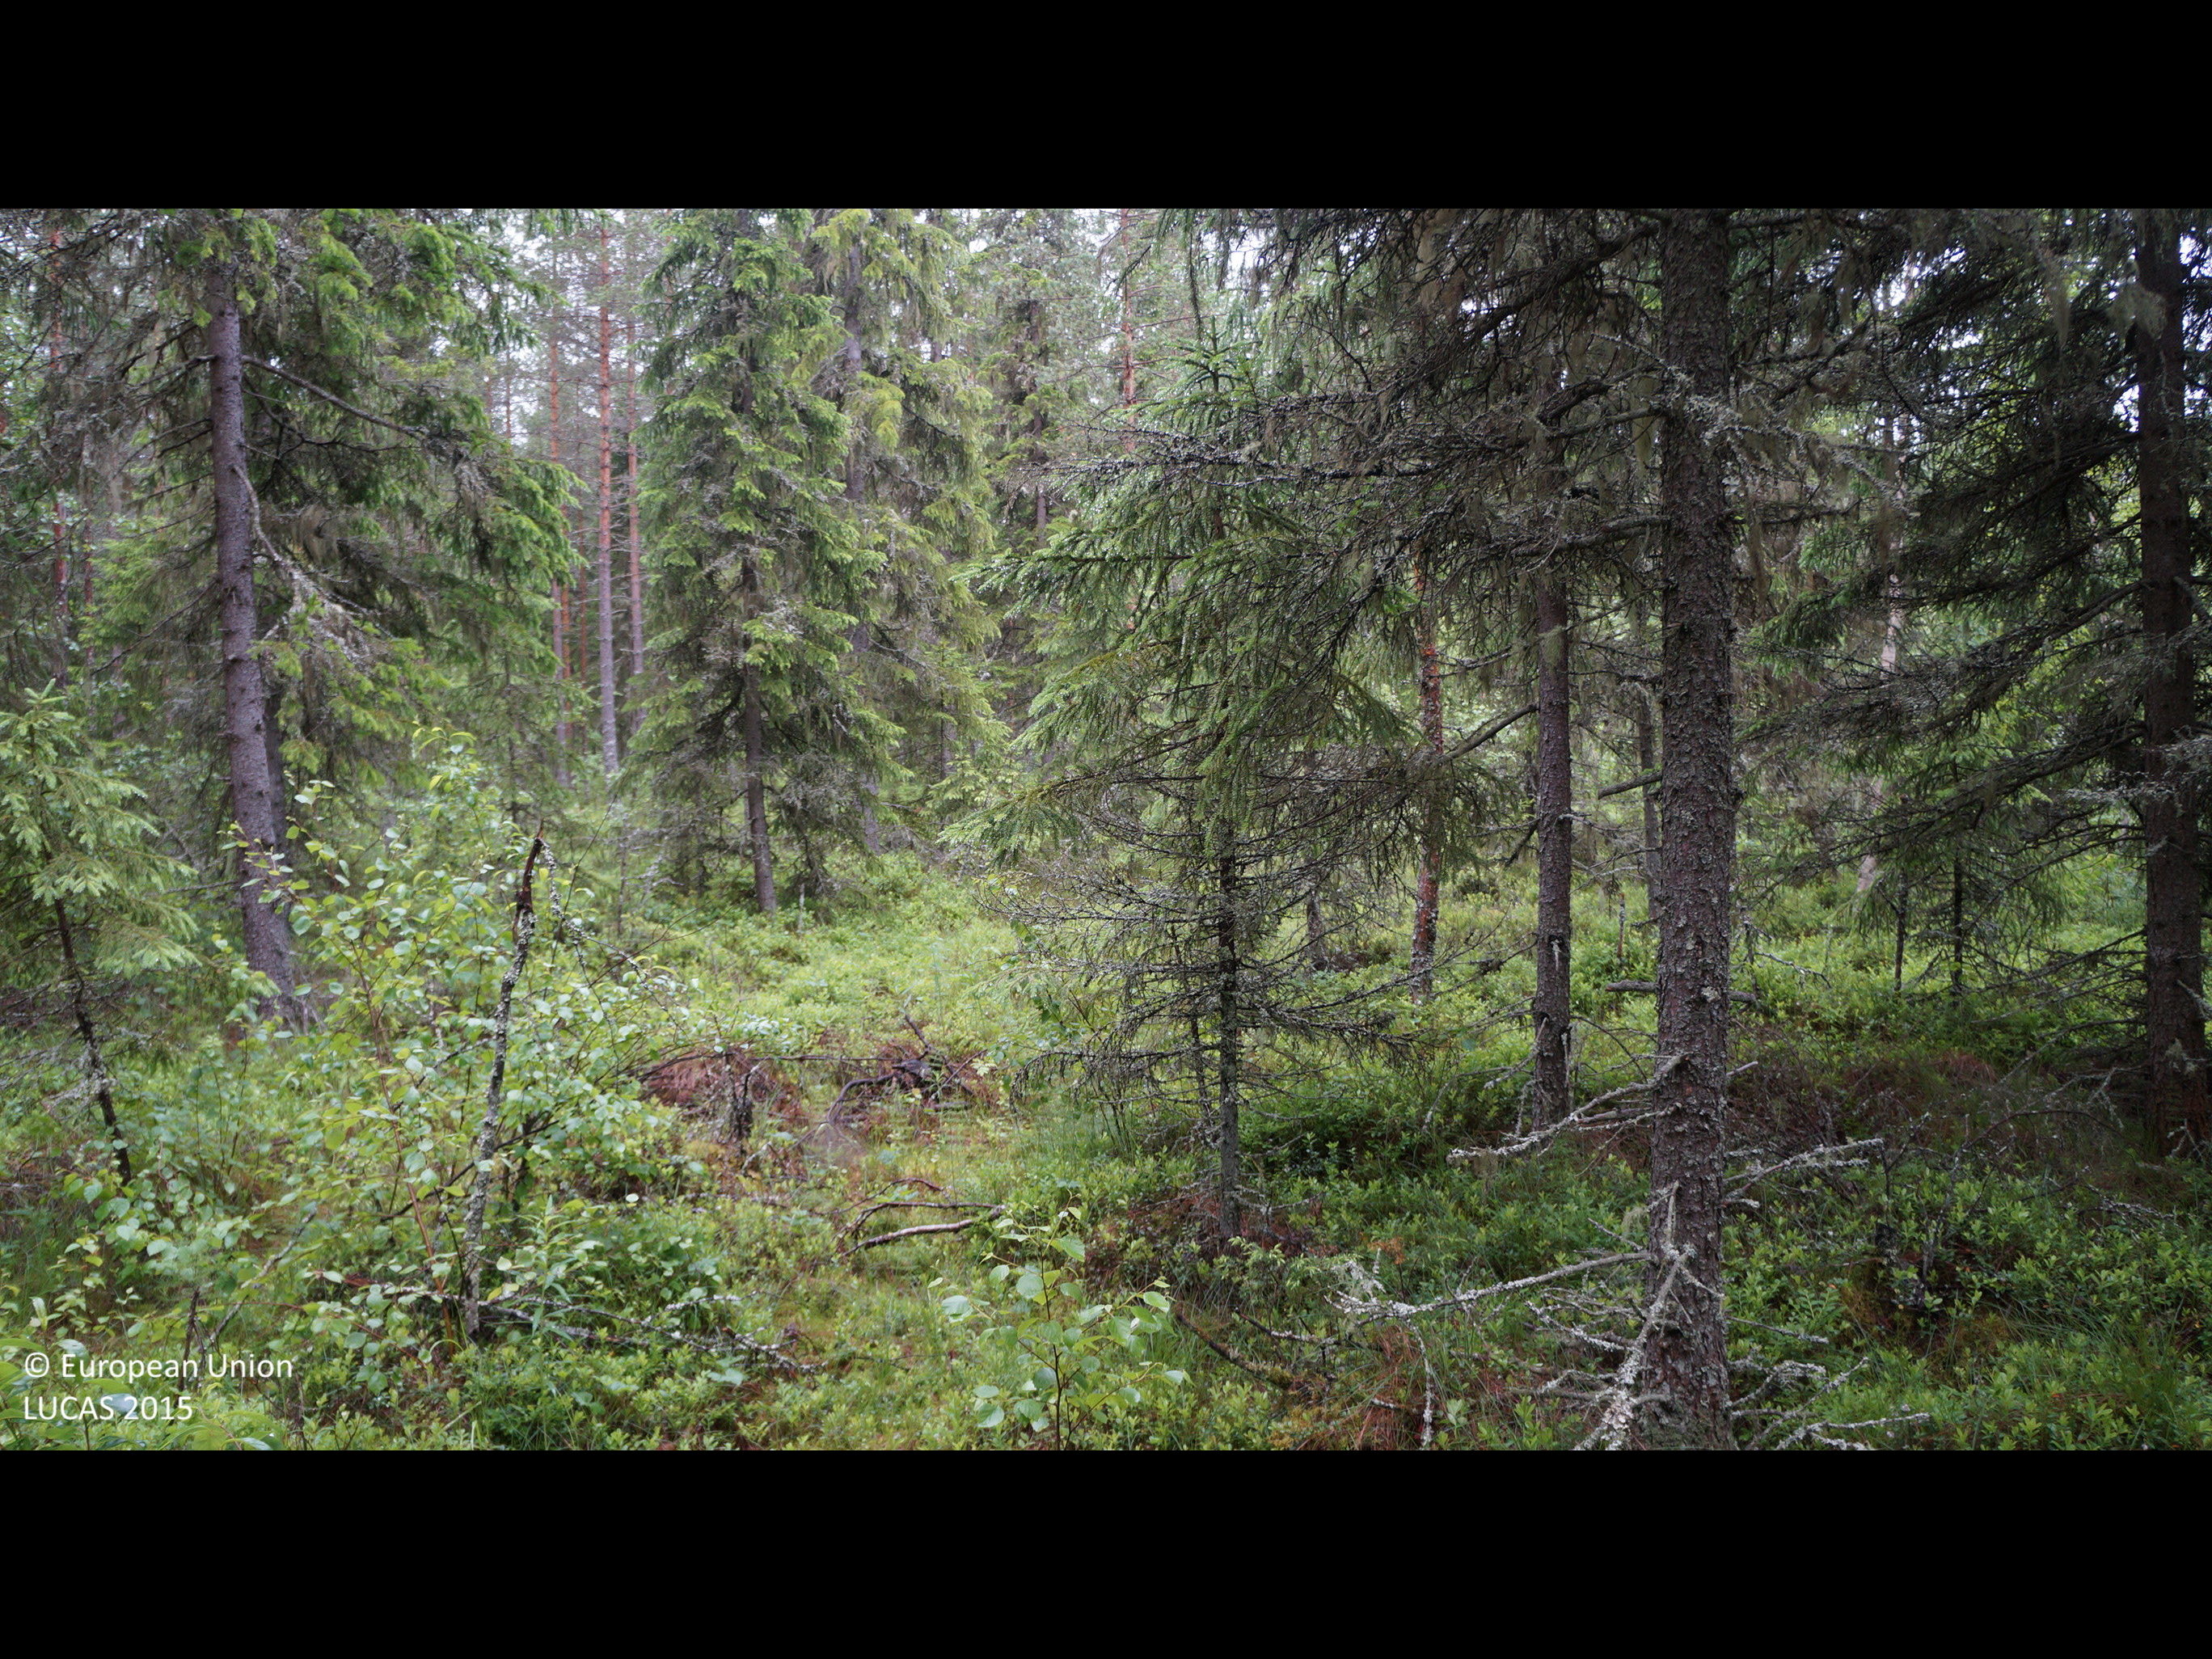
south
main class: Woodland
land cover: Spruce dominated coniferous woodland
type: boreal forest
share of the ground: 50 - 75 %
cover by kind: coniferous forest trees 60 %, shrubs 30 %, broadleaved forest trees 5 %, herbaceous plants 5 %
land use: Forestry
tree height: > 5 m
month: June
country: FI
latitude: 64.3323
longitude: 24.5353
